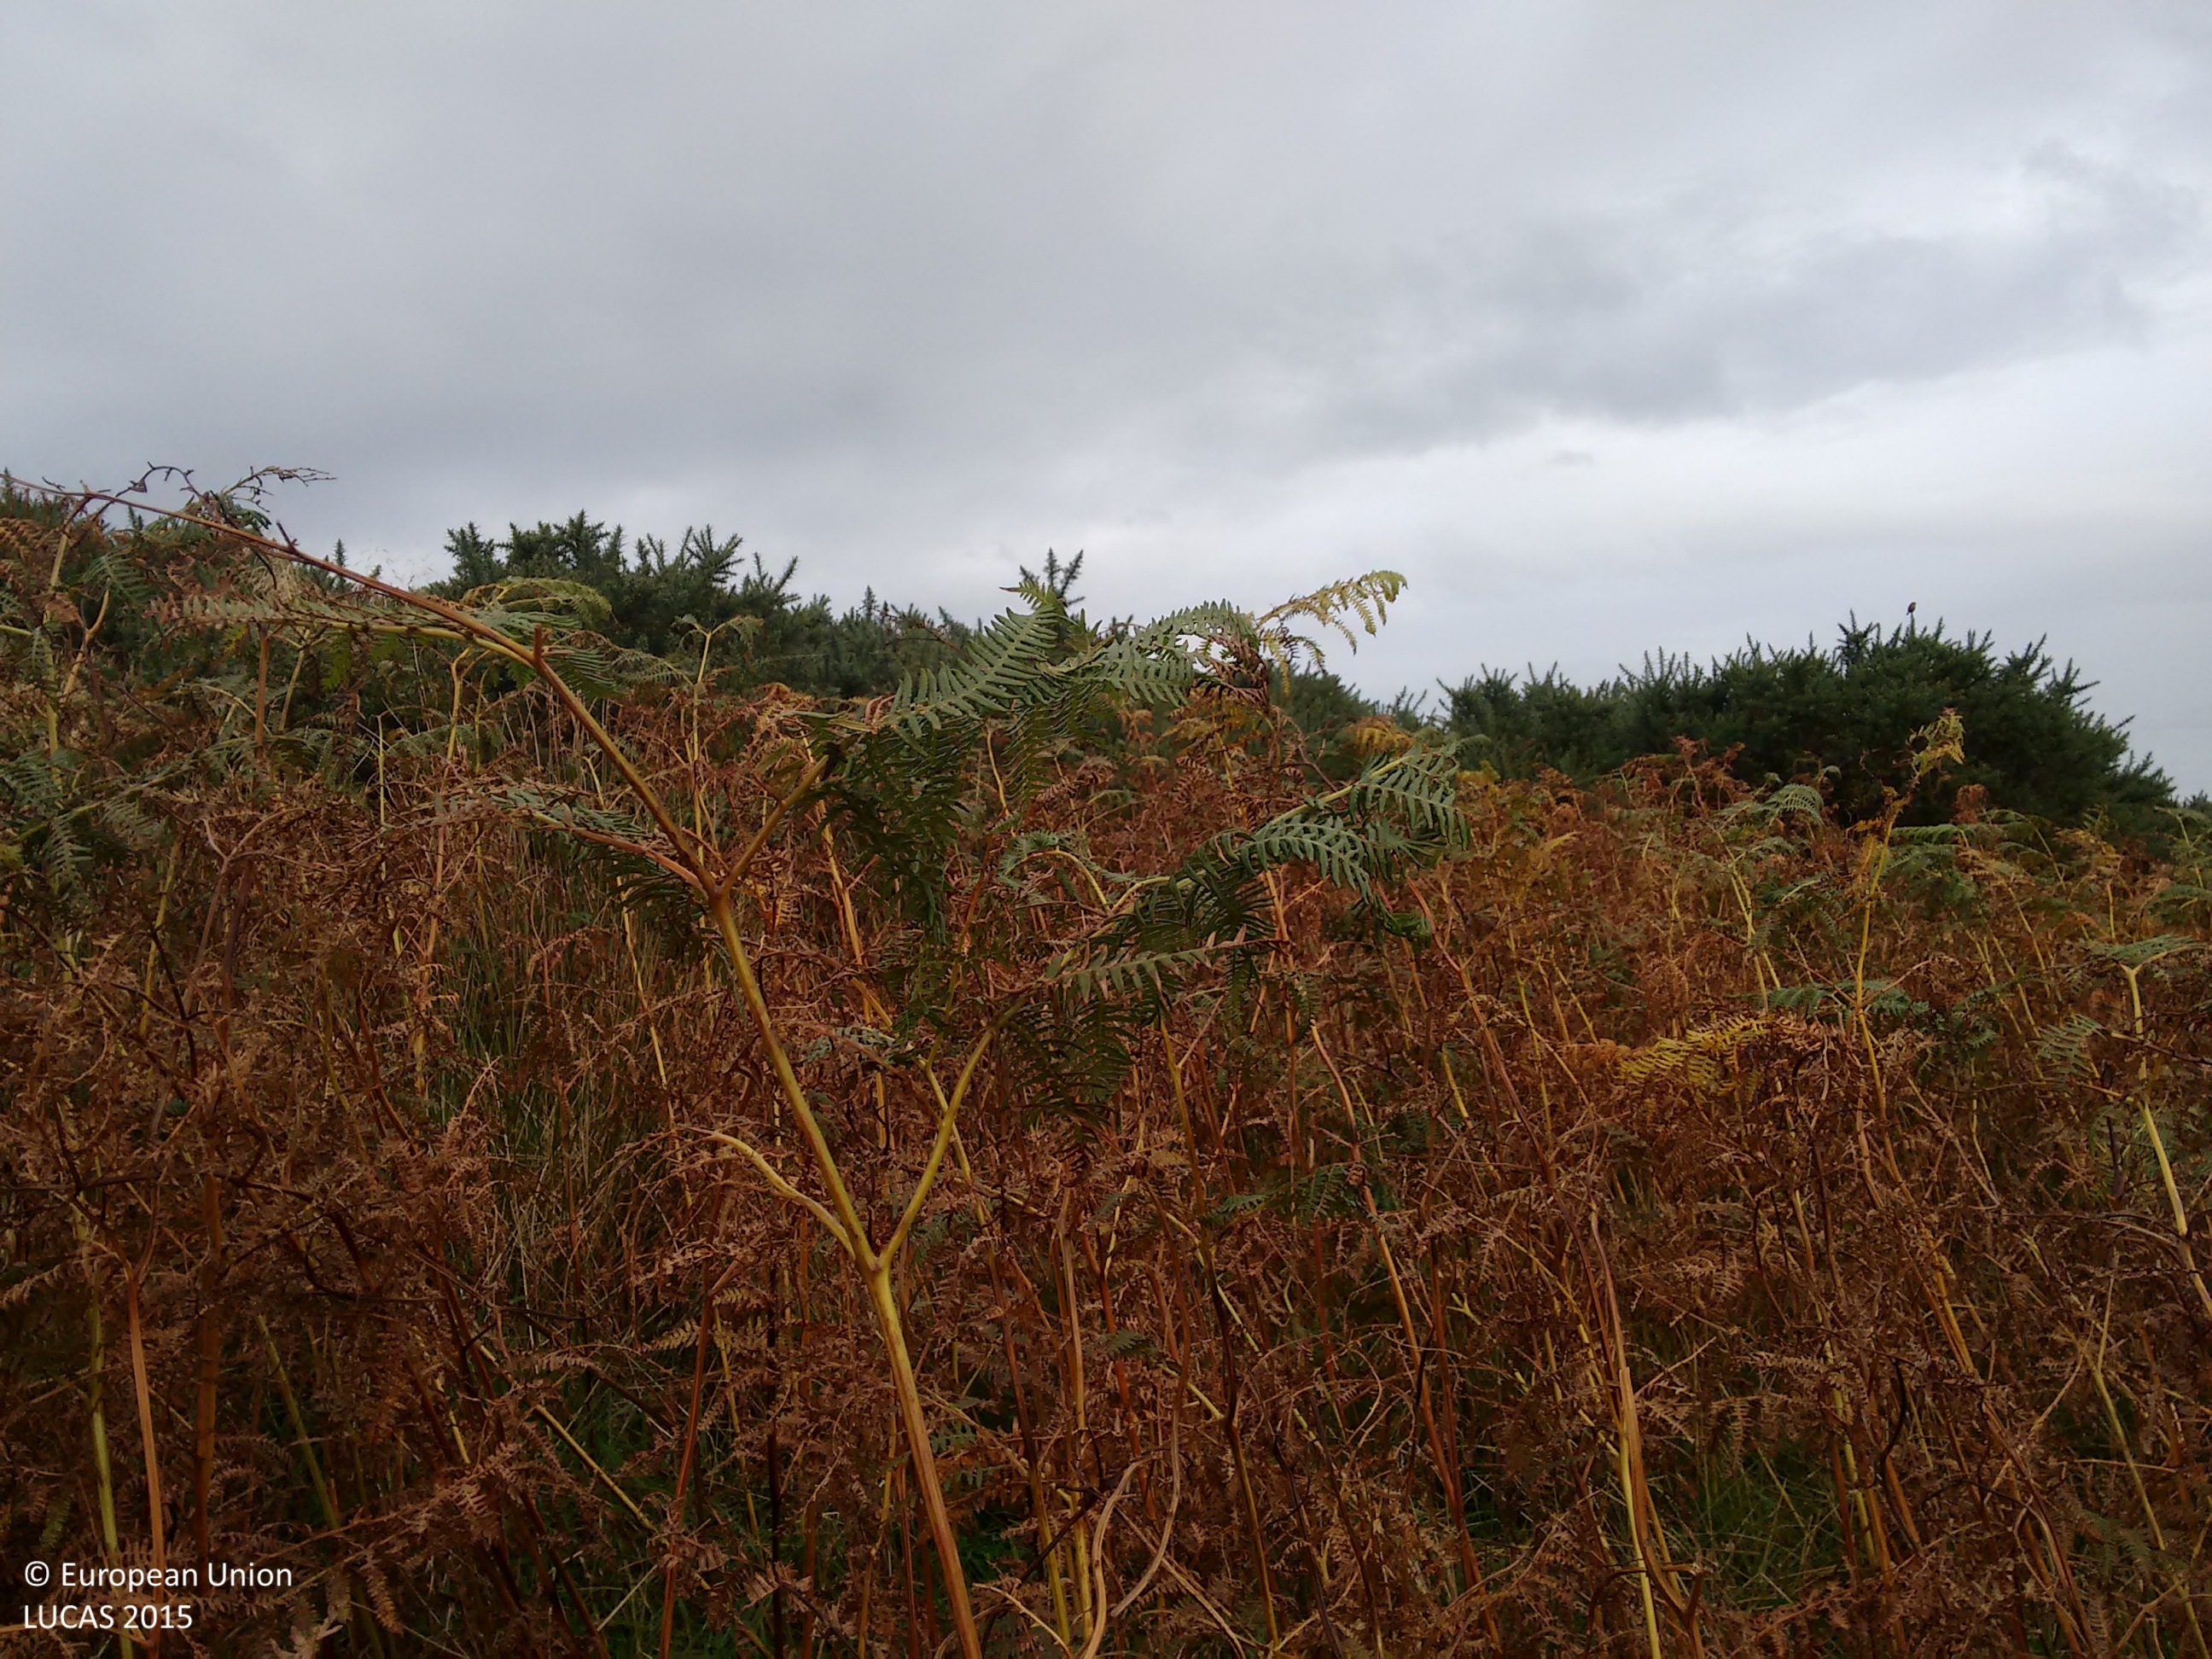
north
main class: Shrubland
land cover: Shrubland with sparse tree cover
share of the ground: > 75 %
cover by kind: shrubs 85 %, herbaceous plants 10 %, broadleaved forest trees 5 %
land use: Agriculture (excluding fallow land and kitchen gardens)
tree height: < 5 m
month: October
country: GB
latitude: 55.9496
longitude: -5.6767
